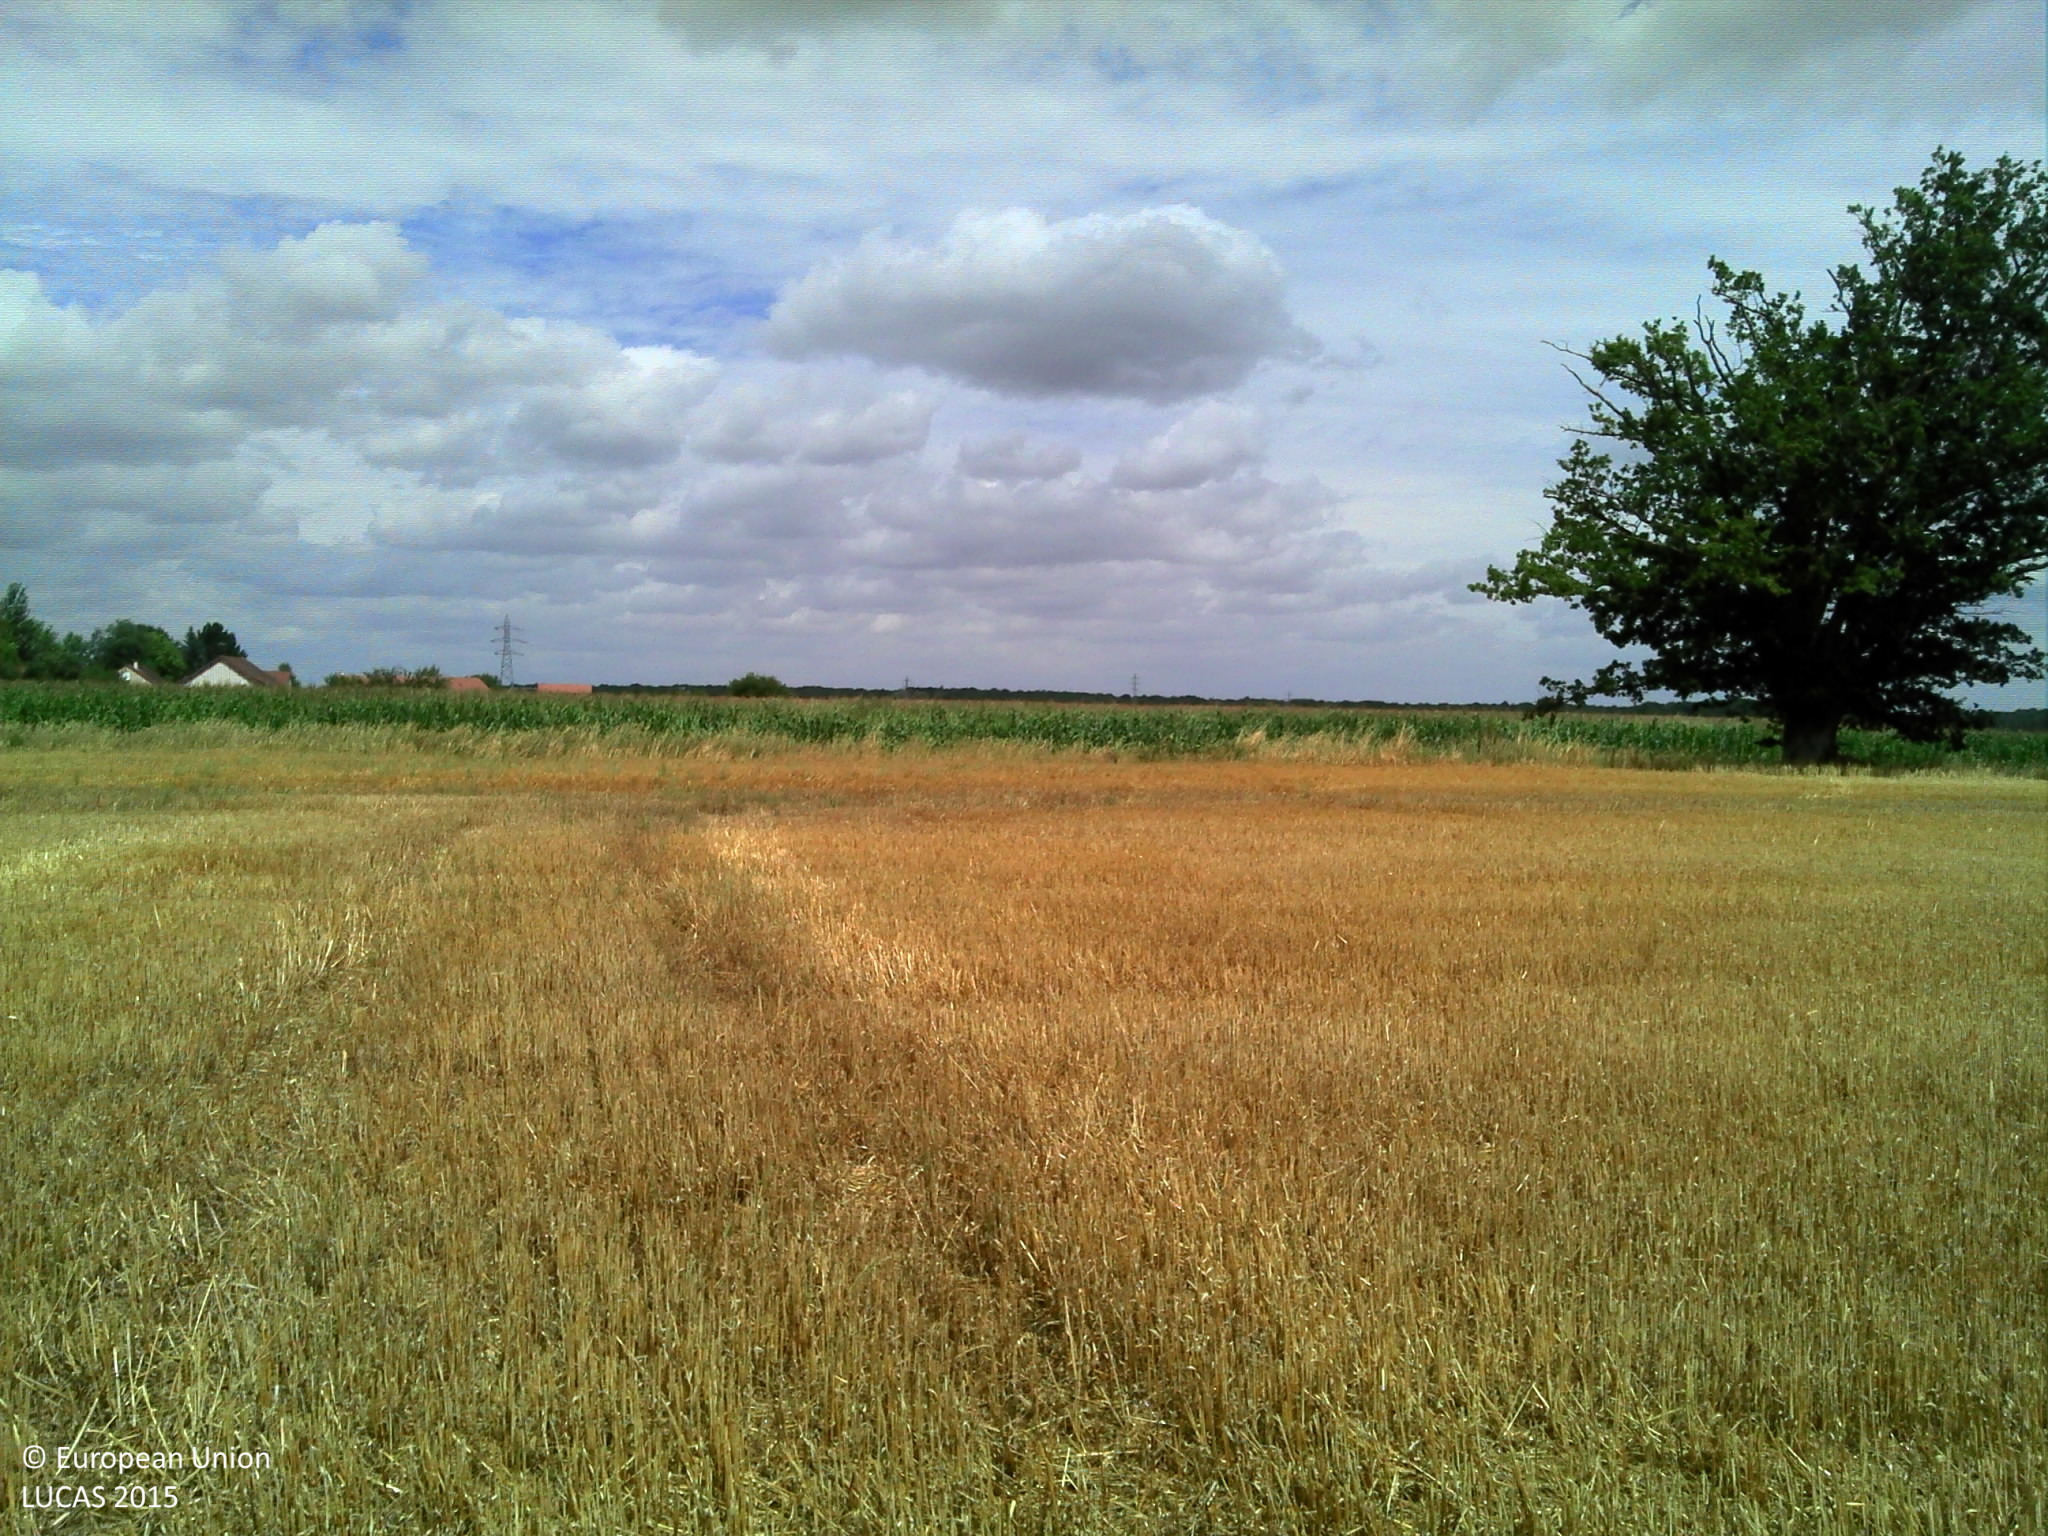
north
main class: Cropland
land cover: Barley
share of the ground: > 75 %
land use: Agriculture (excluding fallow land and kitchen gardens)
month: July
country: FR
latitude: 47.8813
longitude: 3.1071
